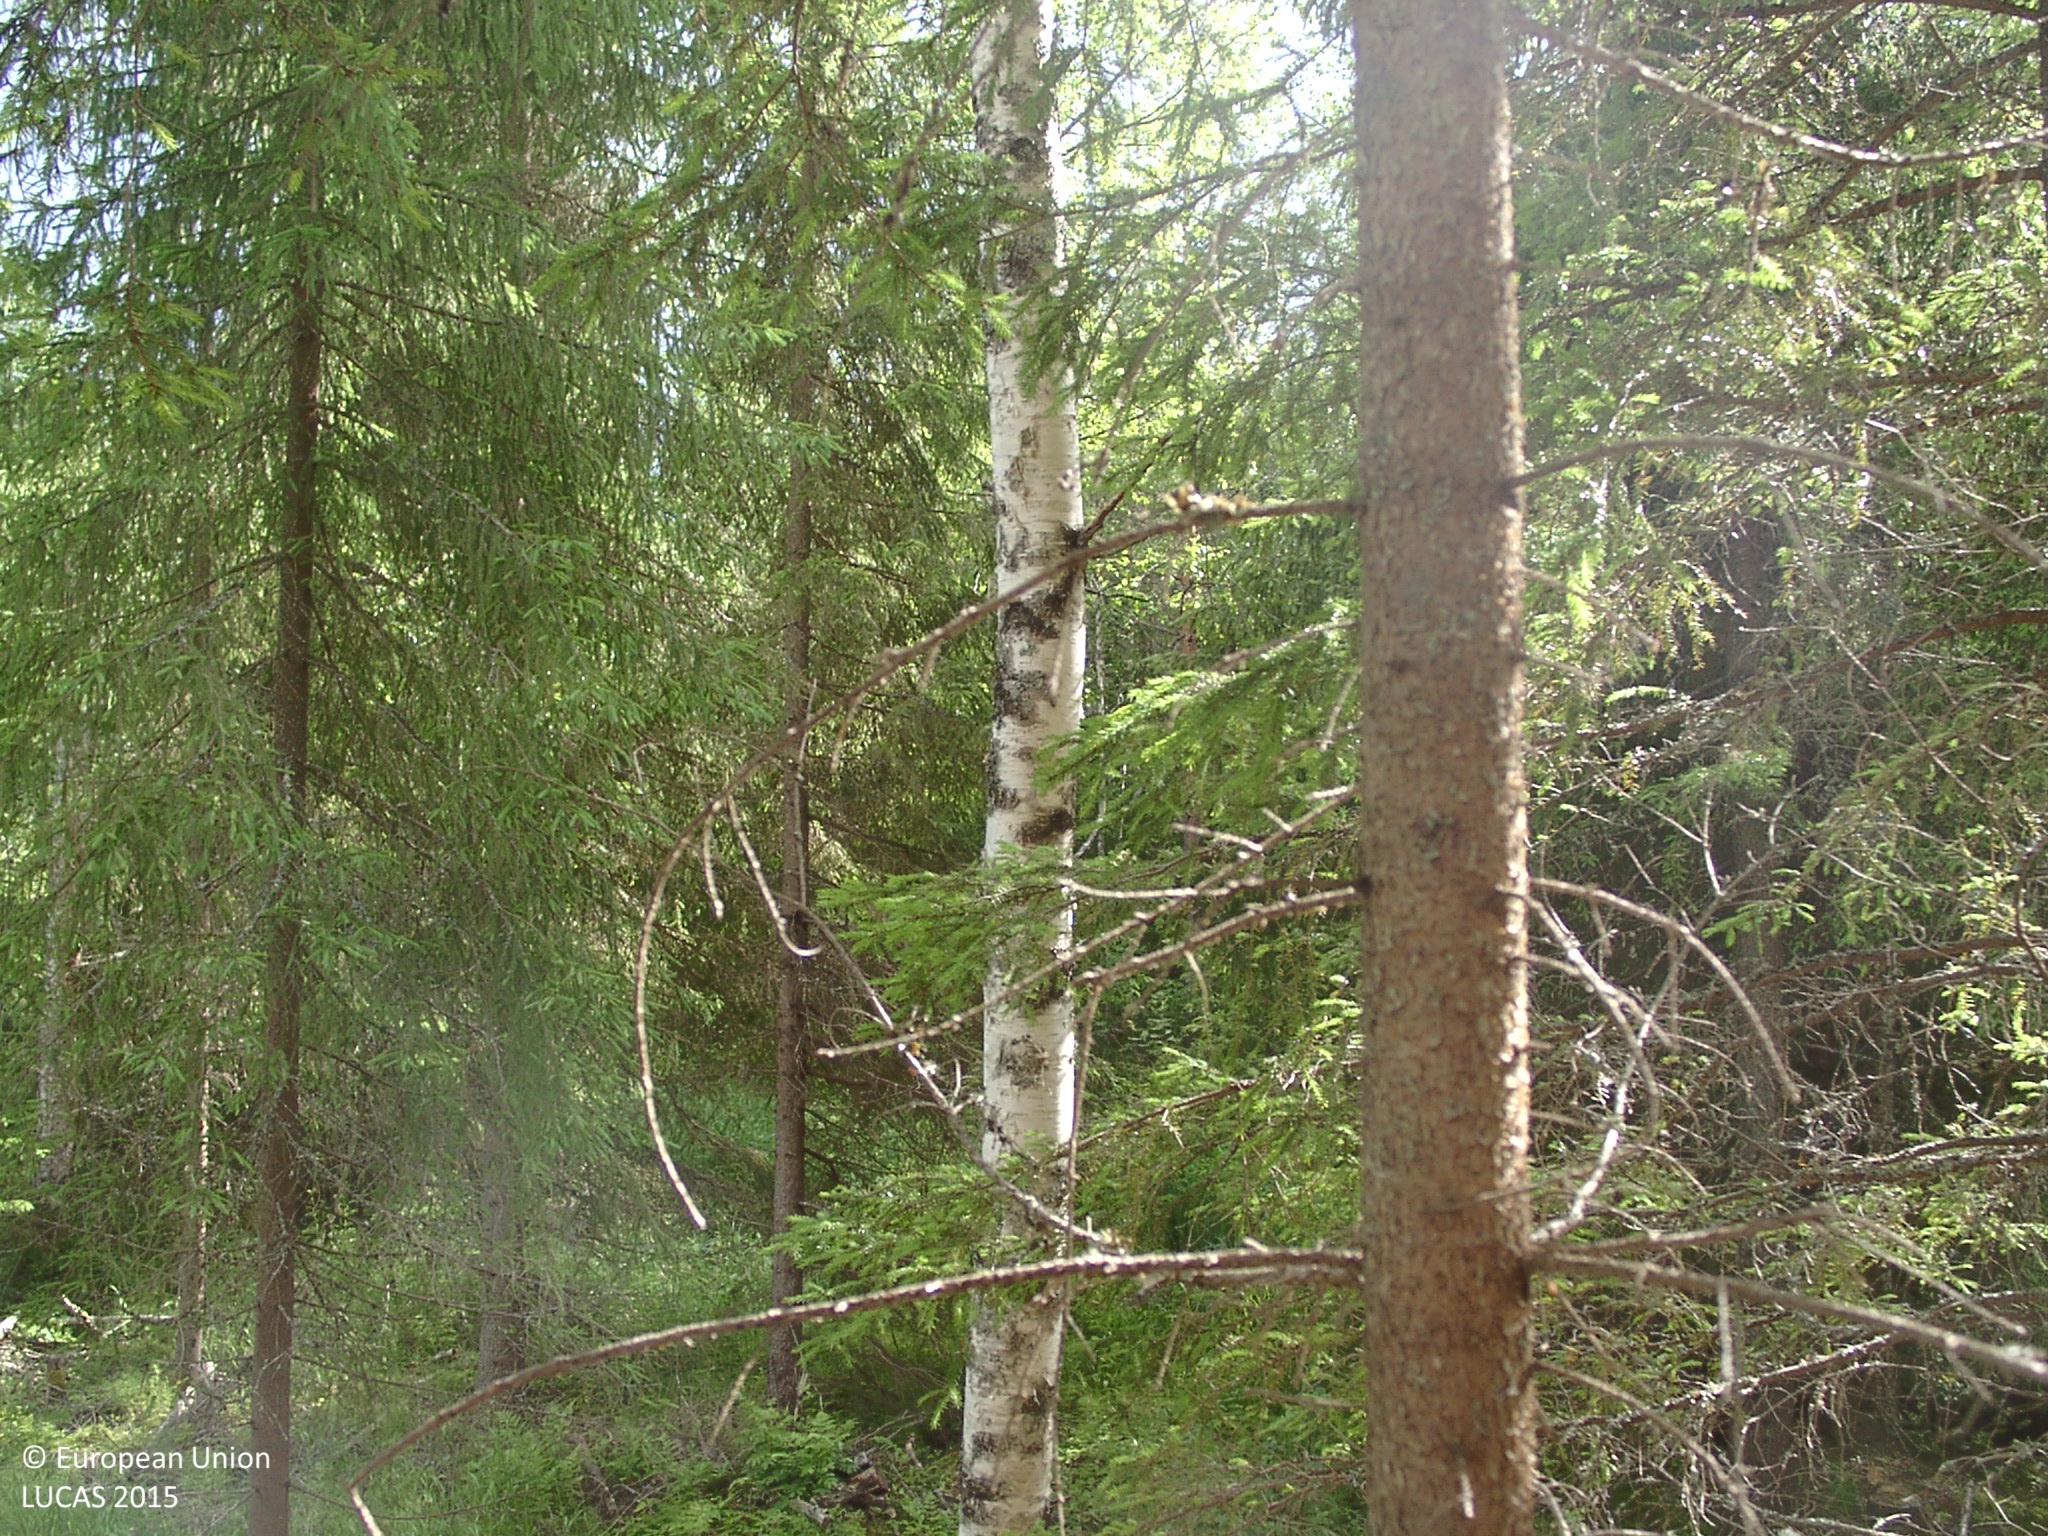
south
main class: Woodland
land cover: Other coniferous woodland
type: boreal forest
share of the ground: > 75 %
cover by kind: coniferous forest trees 70 %, broadleaved forest trees 5 %, unconsolidated bare surface 5 %
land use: Forestry
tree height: > 5 m
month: July
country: FI
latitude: 62.2106
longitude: 25.1217
